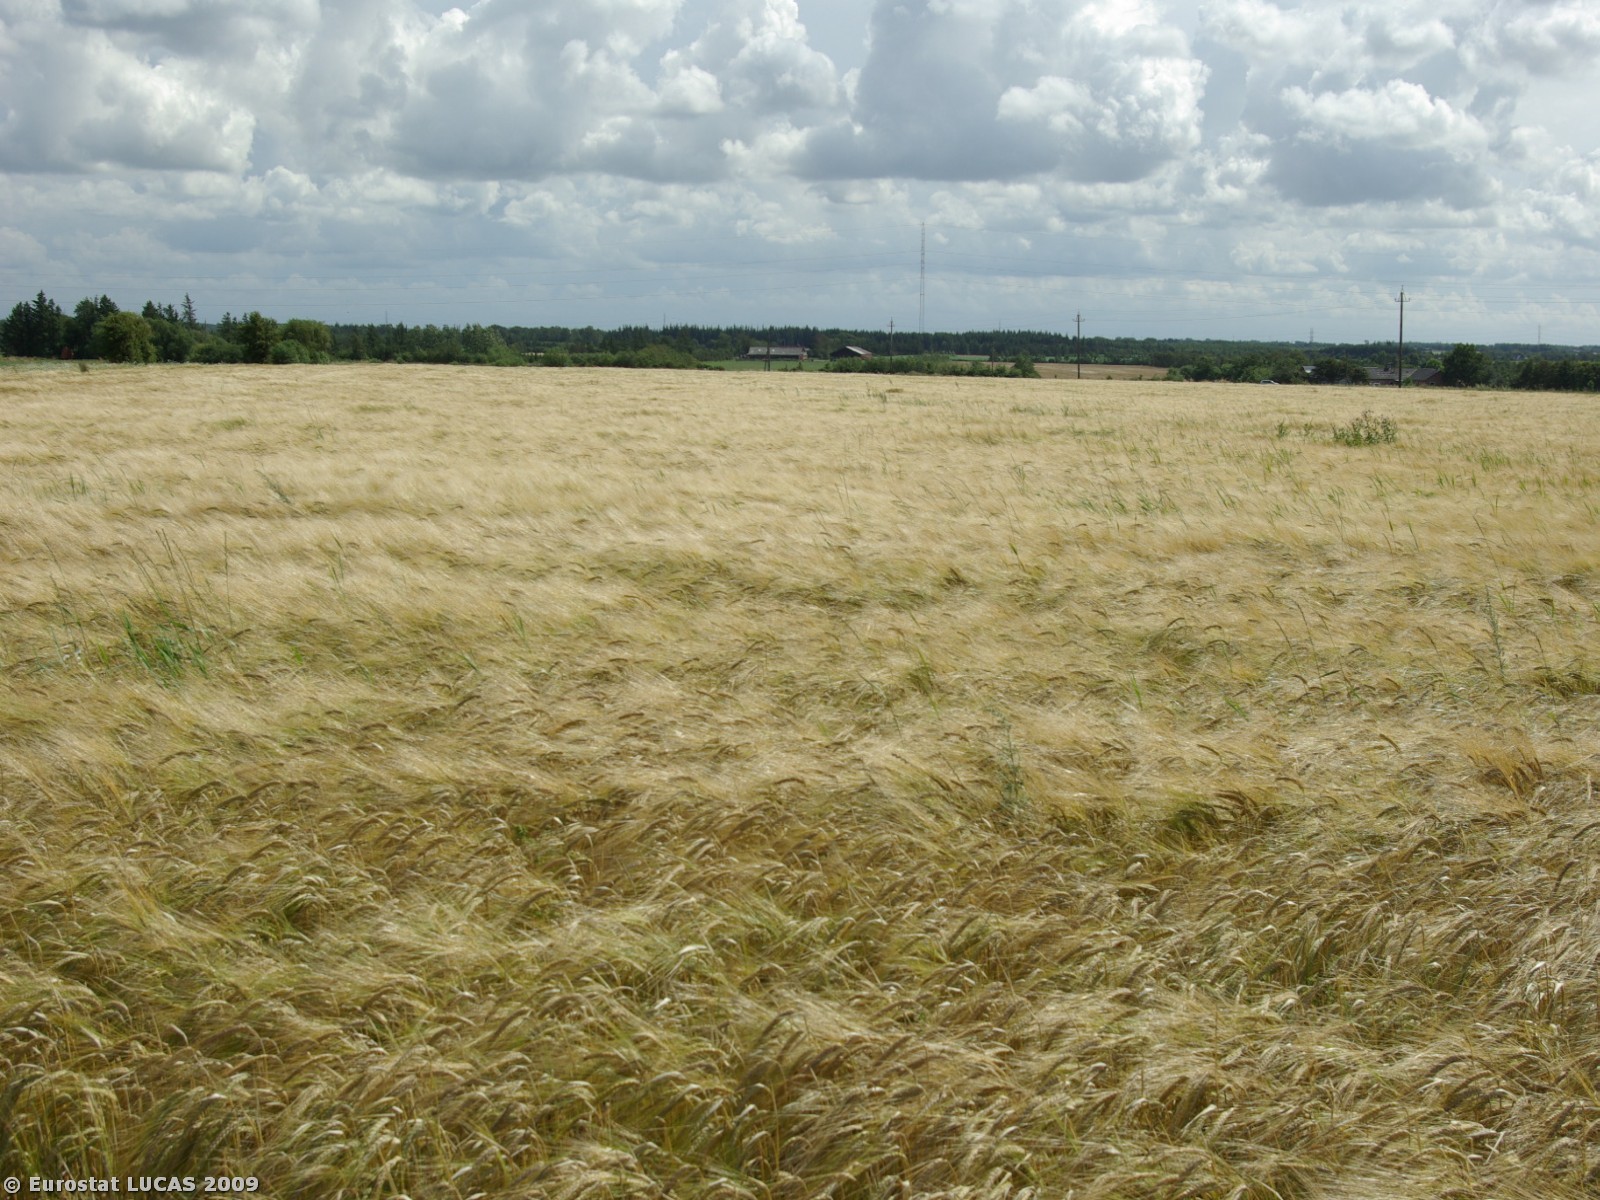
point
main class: Cropland
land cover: Barley
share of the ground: > 75 %
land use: Agriculture (excluding fallow land and kitchen gardens)
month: July
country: DK
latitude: 55.0507
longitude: 8.9208
